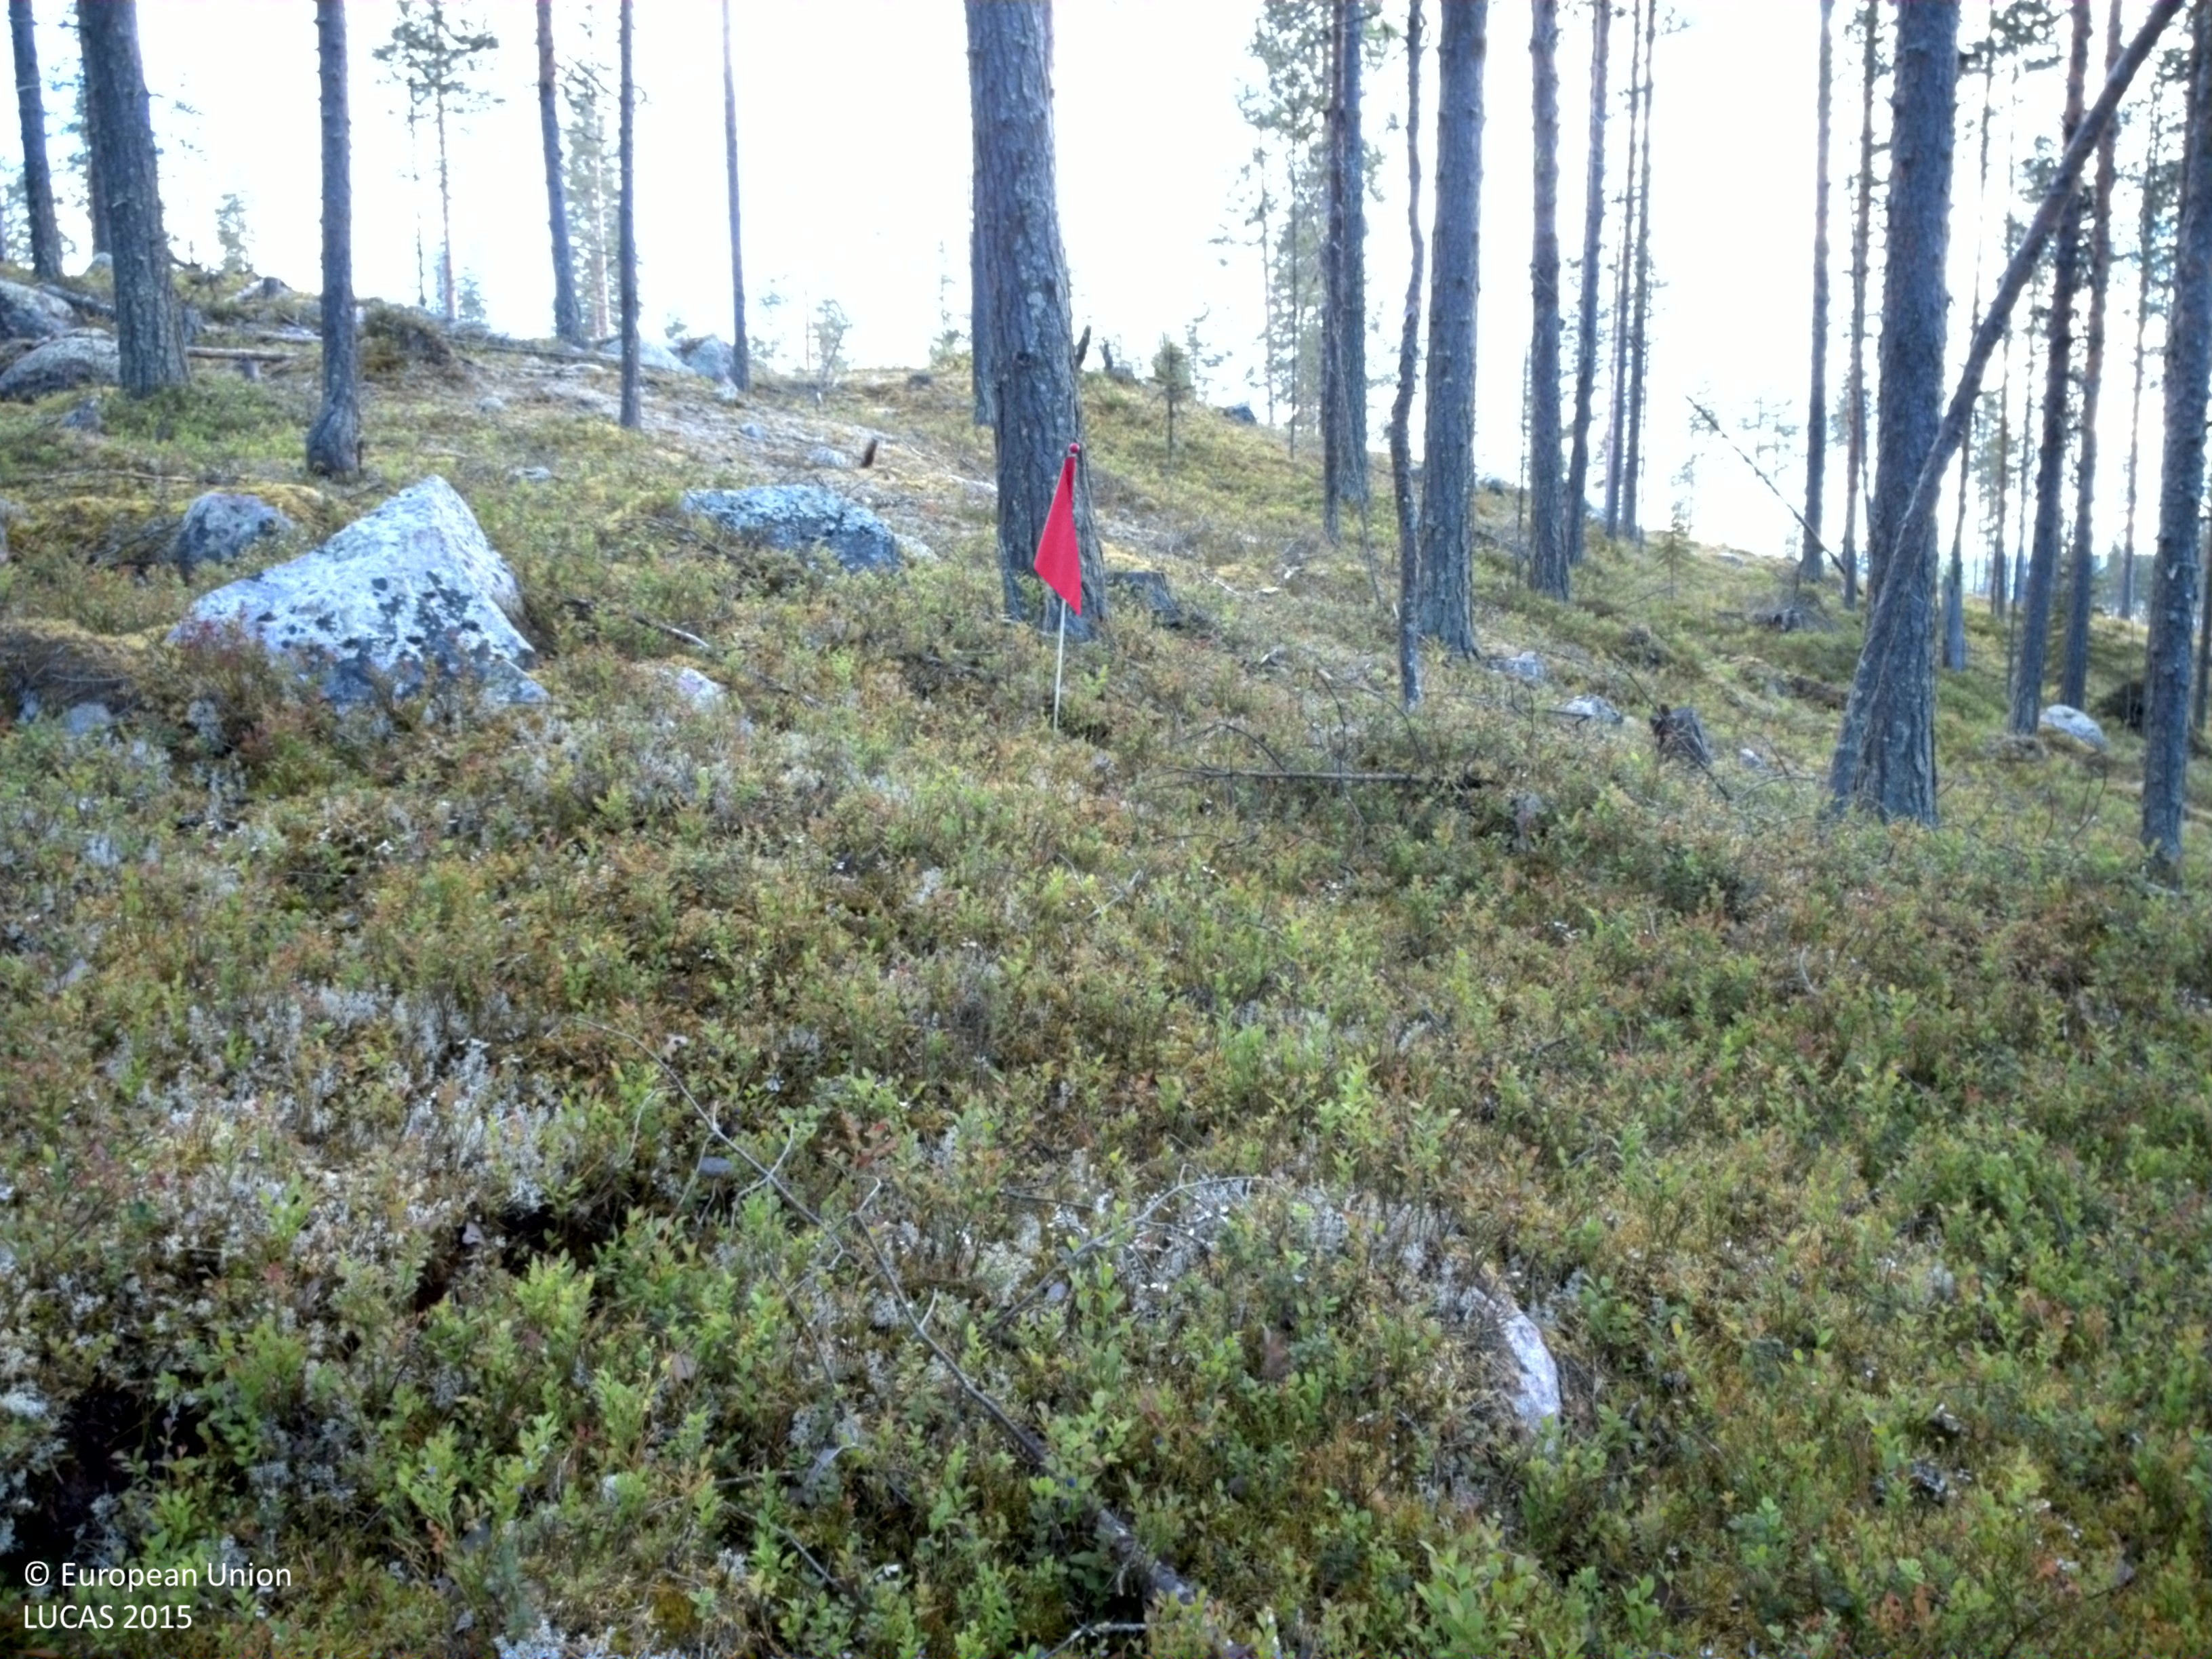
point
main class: Woodland
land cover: Pine dominated coniferous woodland
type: boreal forest
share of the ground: 25 - 50 %
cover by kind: shrubs 60 %, coniferous forest trees 30 %, lichens and mosses 5 %, consolidated bare surface 5 %
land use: Forestry
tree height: > 5 m
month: August
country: SE
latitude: 66.4481
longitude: 20.7005
